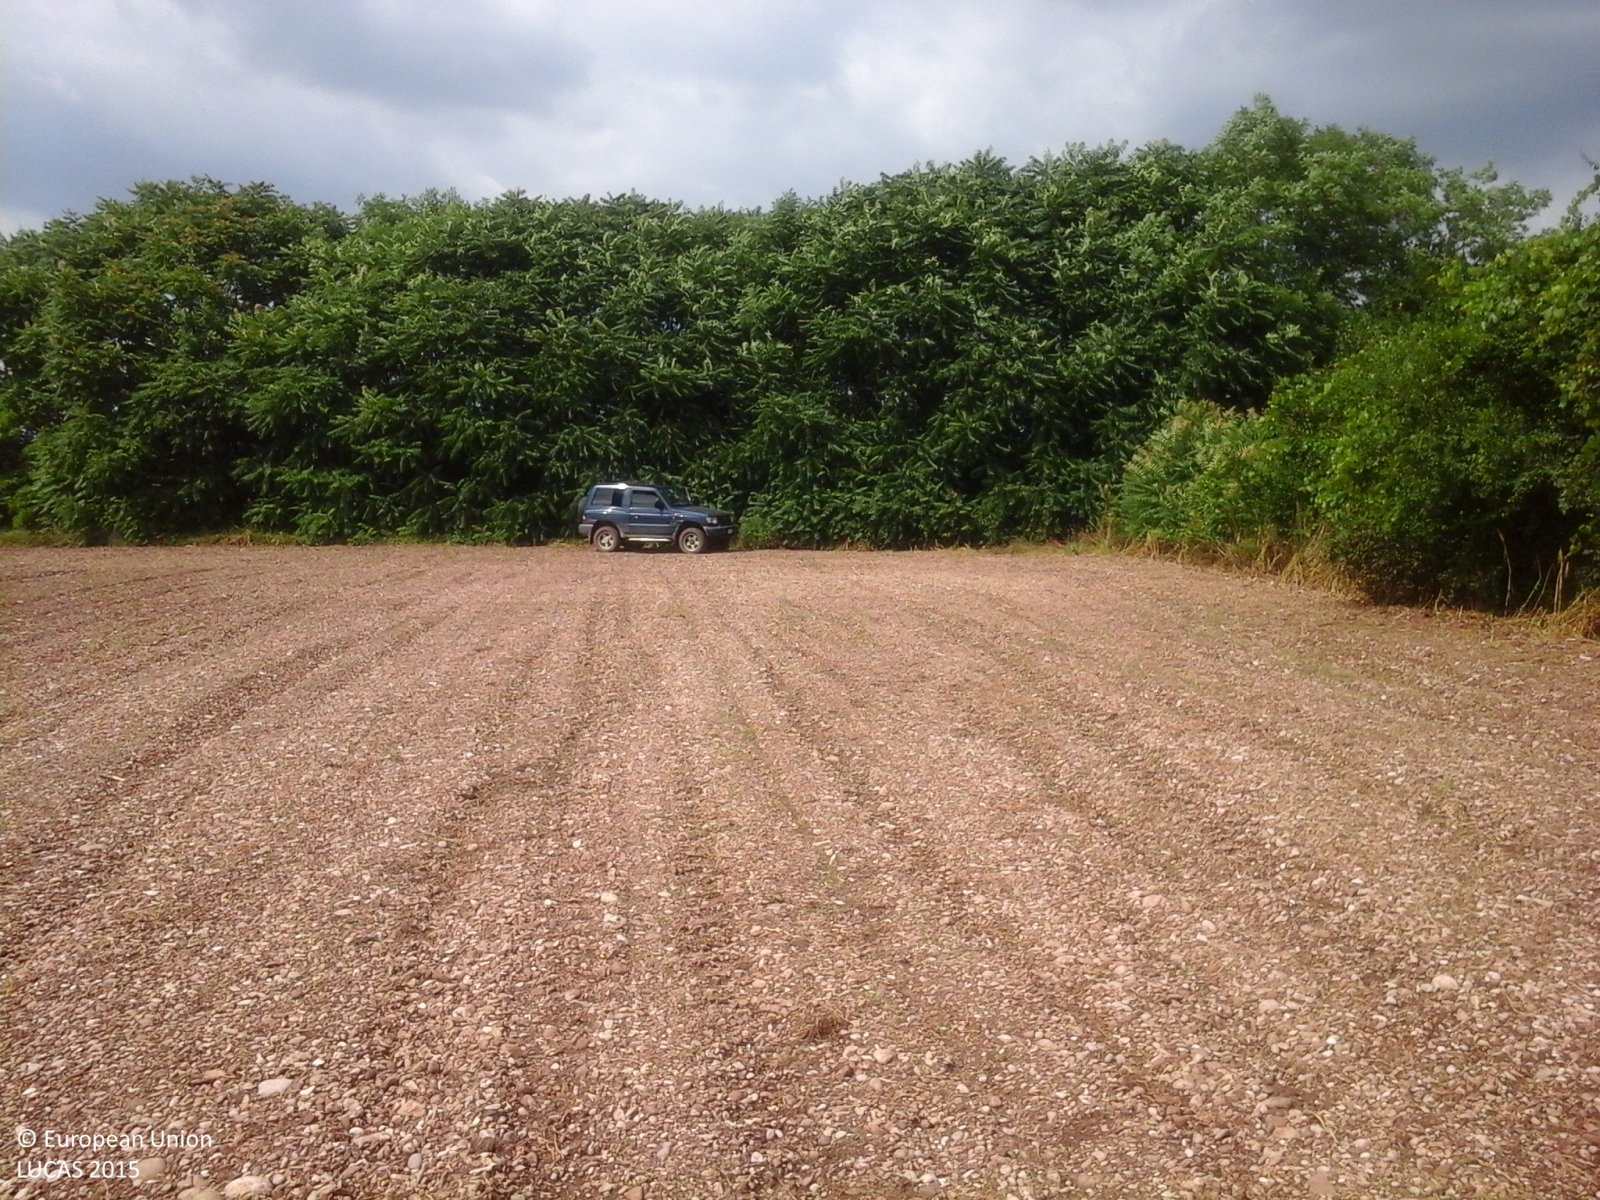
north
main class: Cropland
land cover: Common wheat
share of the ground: < 10 %
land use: Agriculture (excluding fallow land and kitchen gardens)
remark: Harvested field
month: June
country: IT
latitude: 45.7695
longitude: 12.2215
